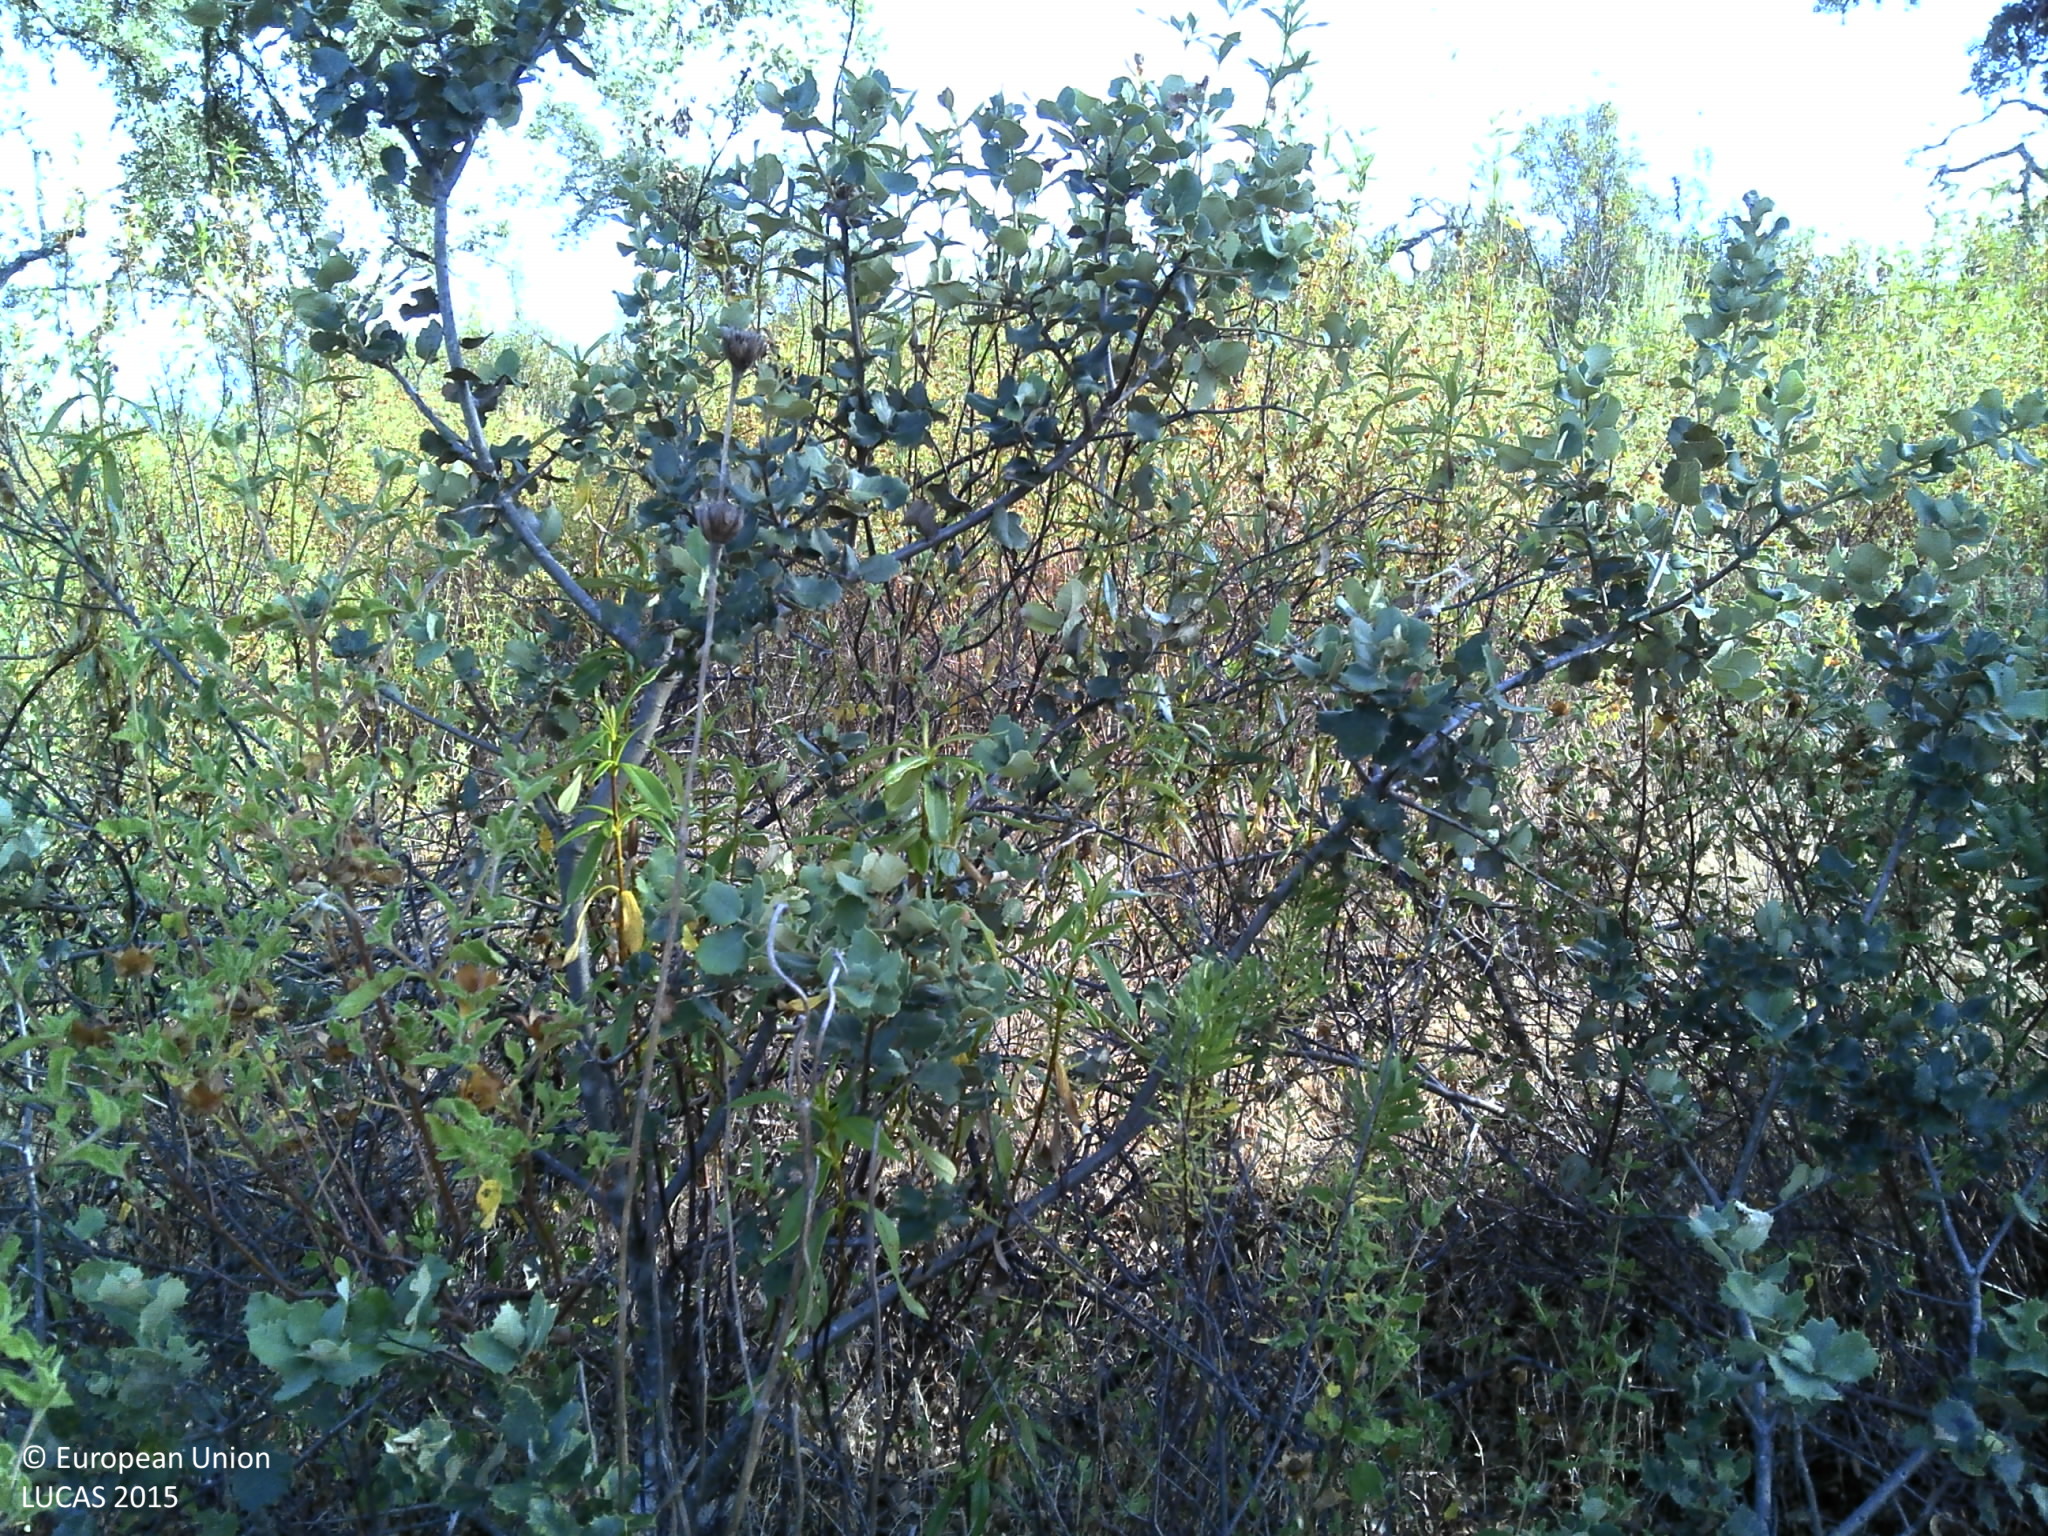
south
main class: Woodland
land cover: Broadleaved woodland
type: broadleaved evergreen forest
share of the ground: 25 - 50 %
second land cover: Shrubland without tree cover
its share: 50 - 75 %
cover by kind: shrubs 50 %, broadleaved forest trees 45 %, herbaceous plants 5 %
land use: Forestry
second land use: Agriculture (excluding fallow land and kitchen gardens)
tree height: < 5 m
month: June
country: PT
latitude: 37.7113
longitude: -7.4474
